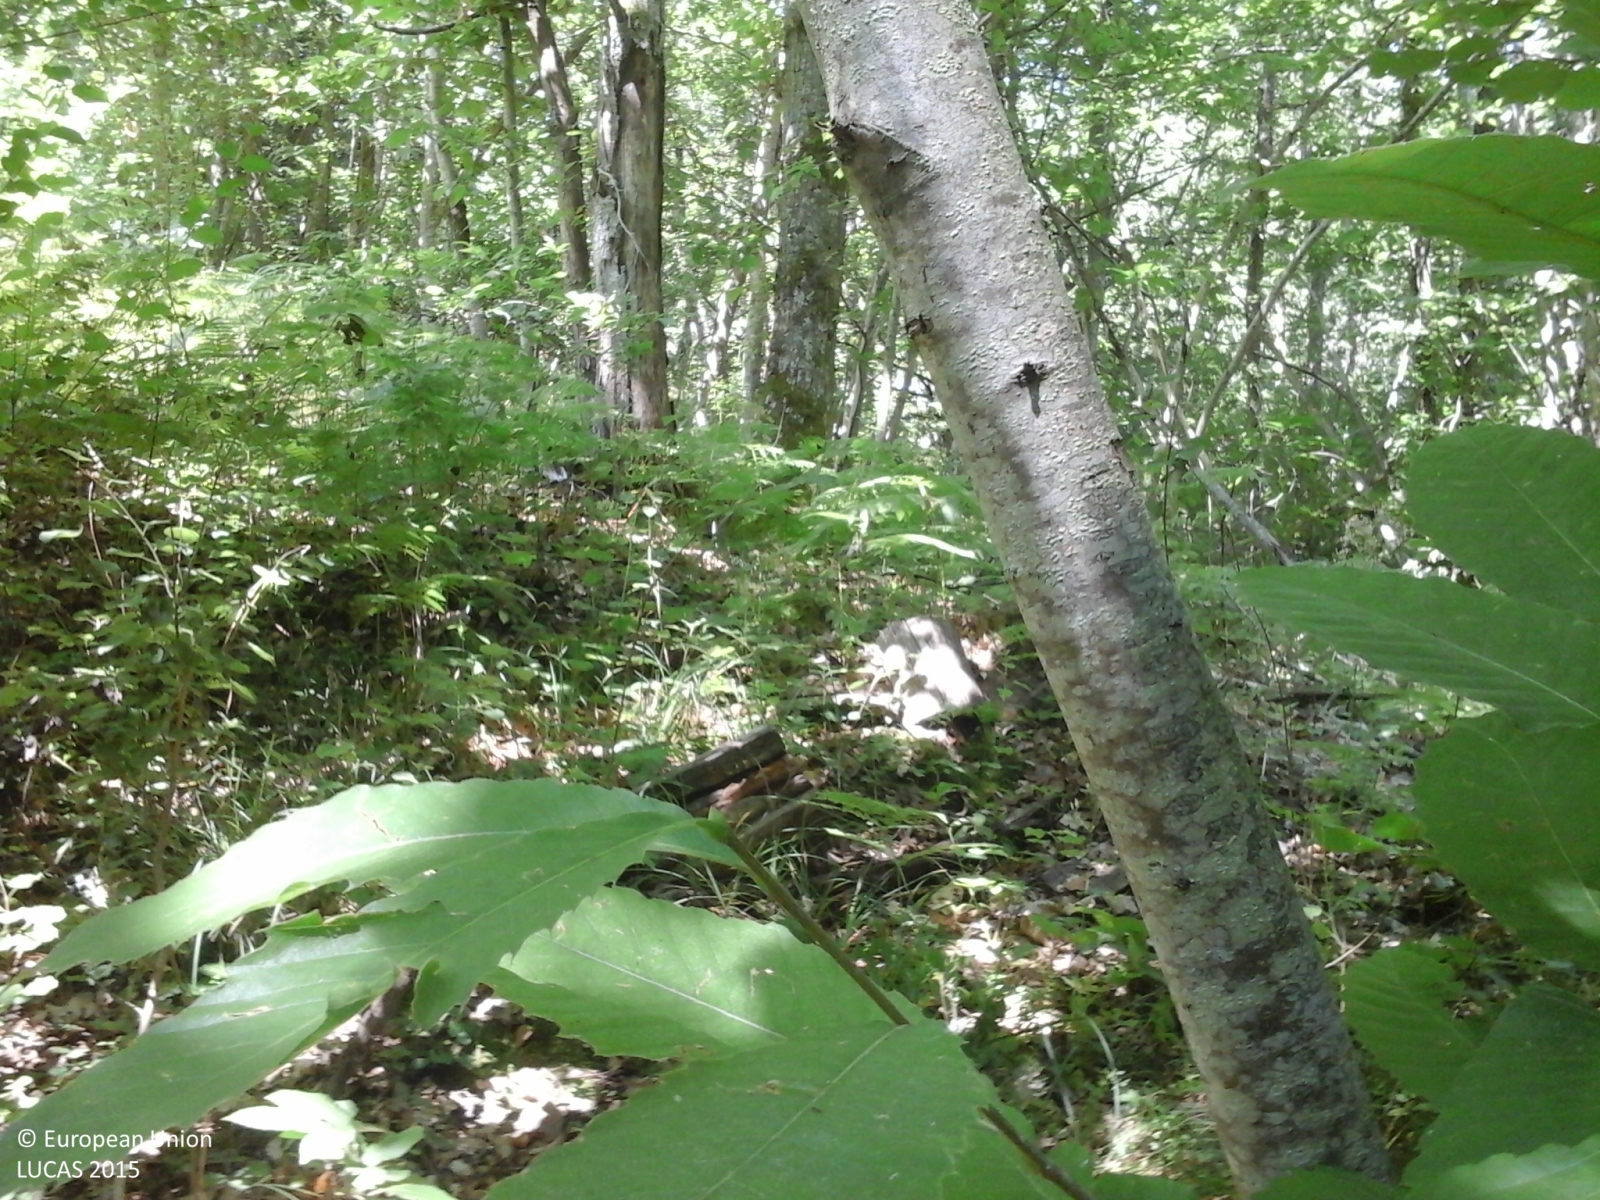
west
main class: Woodland
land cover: Broadleaved woodland
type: thermophilous deciduous forest
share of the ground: > 75 %
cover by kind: broadleaved forest trees 100 %
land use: Forestry
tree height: > 5 m
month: July
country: IT
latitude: 44.2552
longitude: 11.0371
